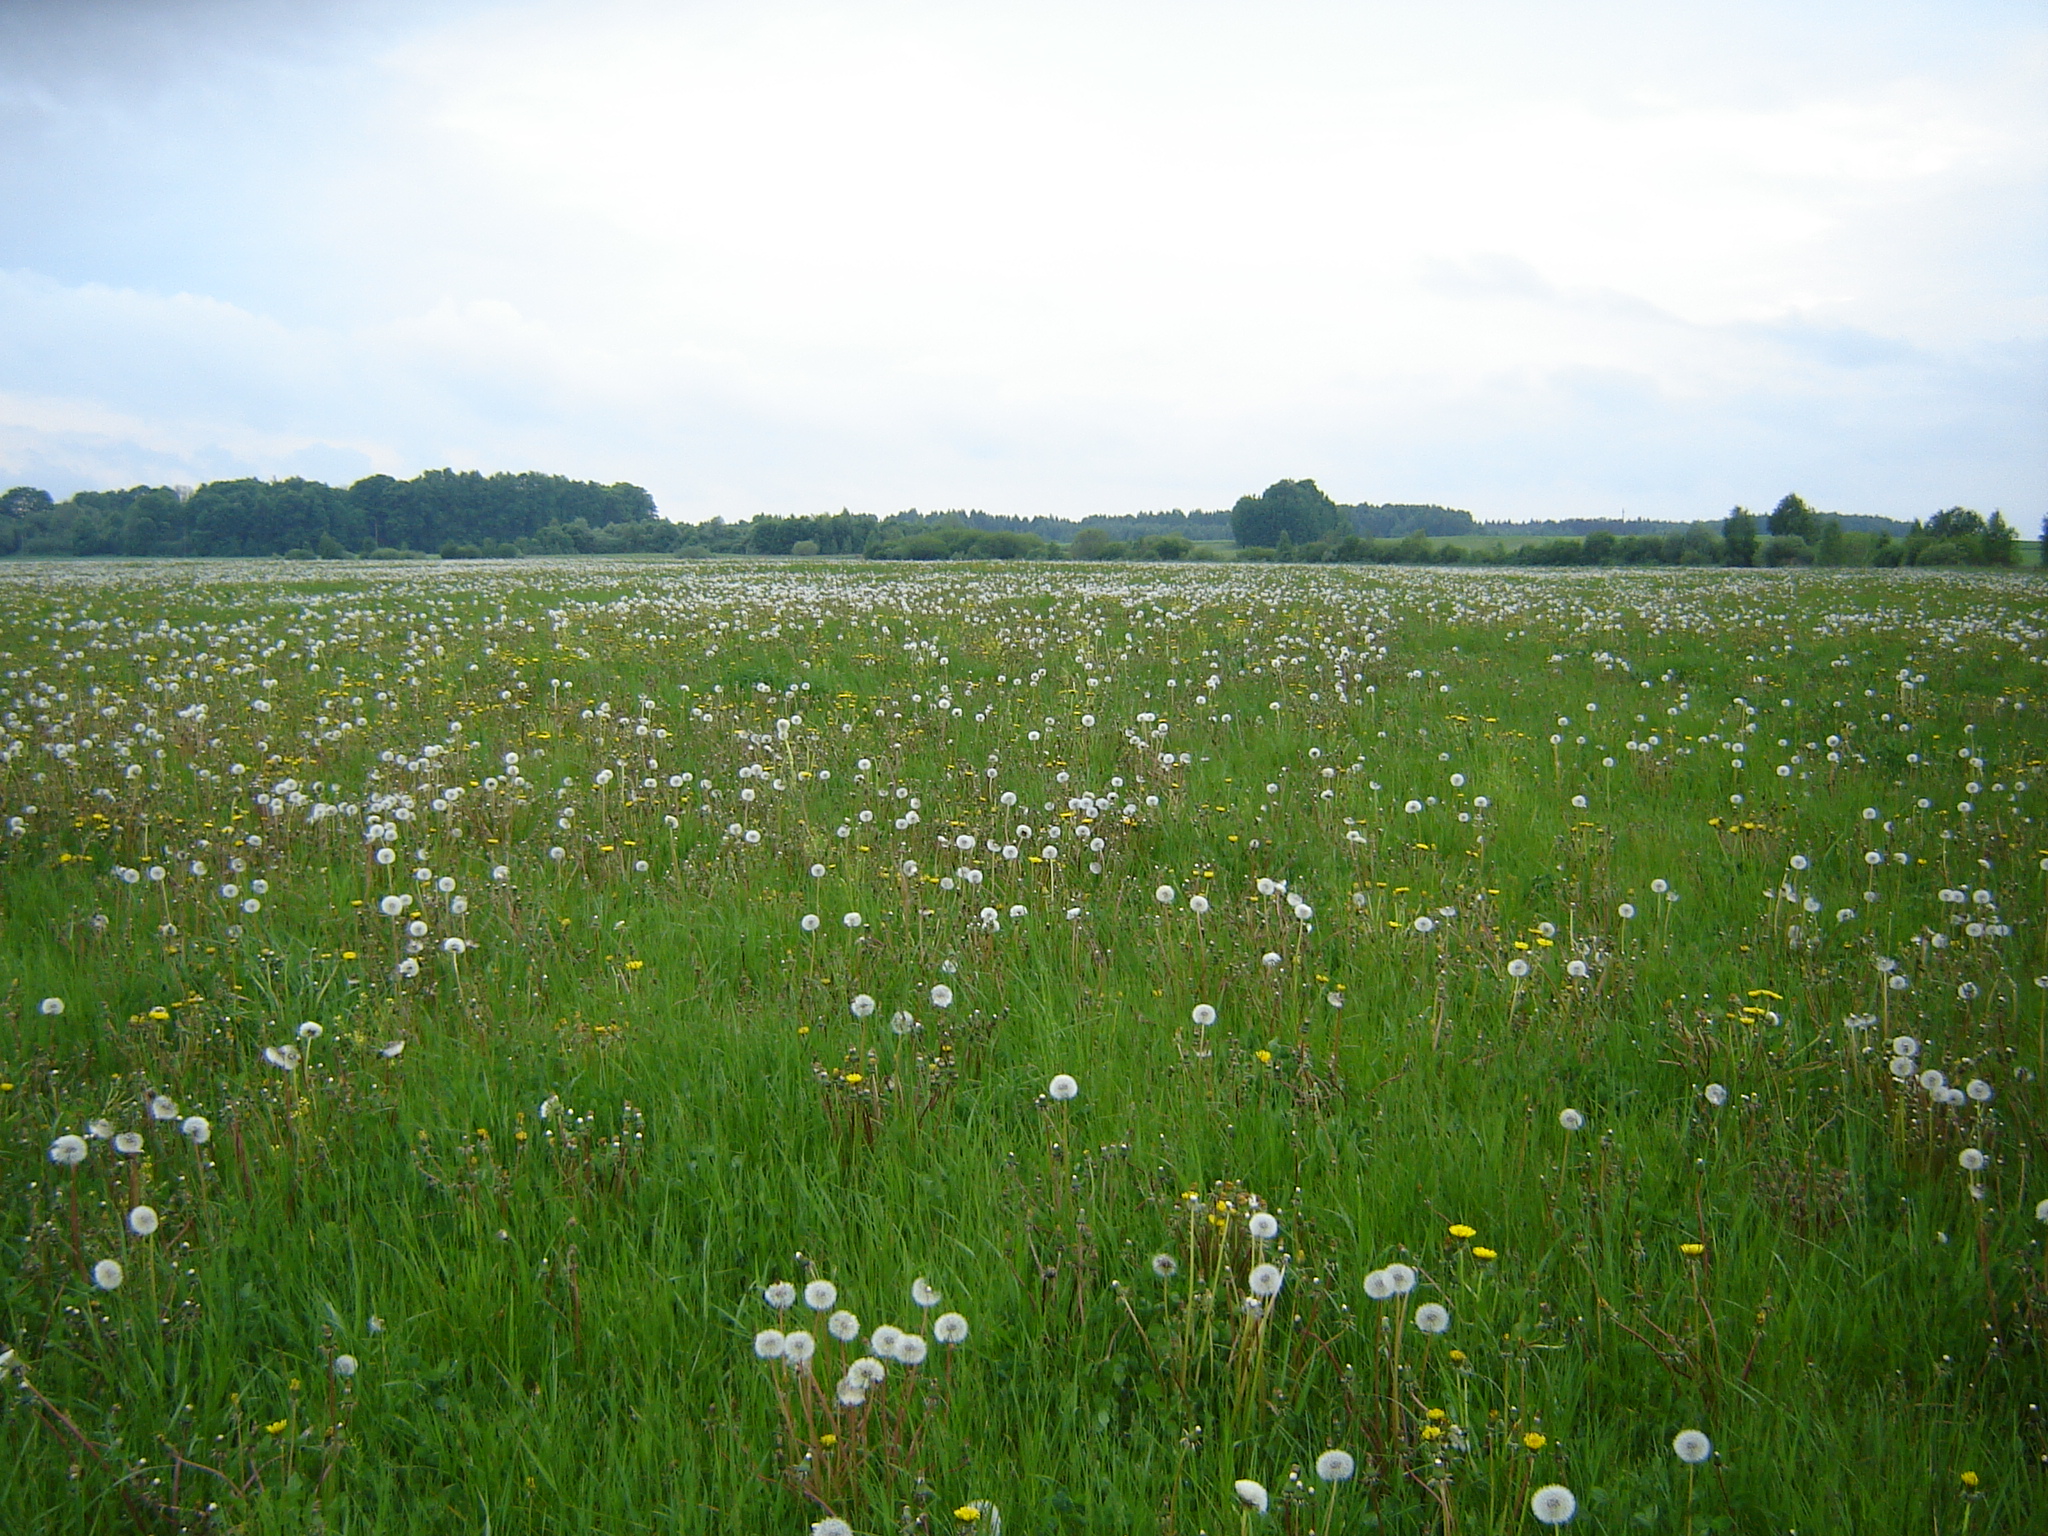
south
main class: Grassland
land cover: Grassland without tree/shrub cover
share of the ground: > 75 %
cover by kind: herbaceous plants 100 %
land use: Agriculture (excluding fallow land and kitchen gardens)
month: May
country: LT
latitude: 55.9958
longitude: 25.3006
